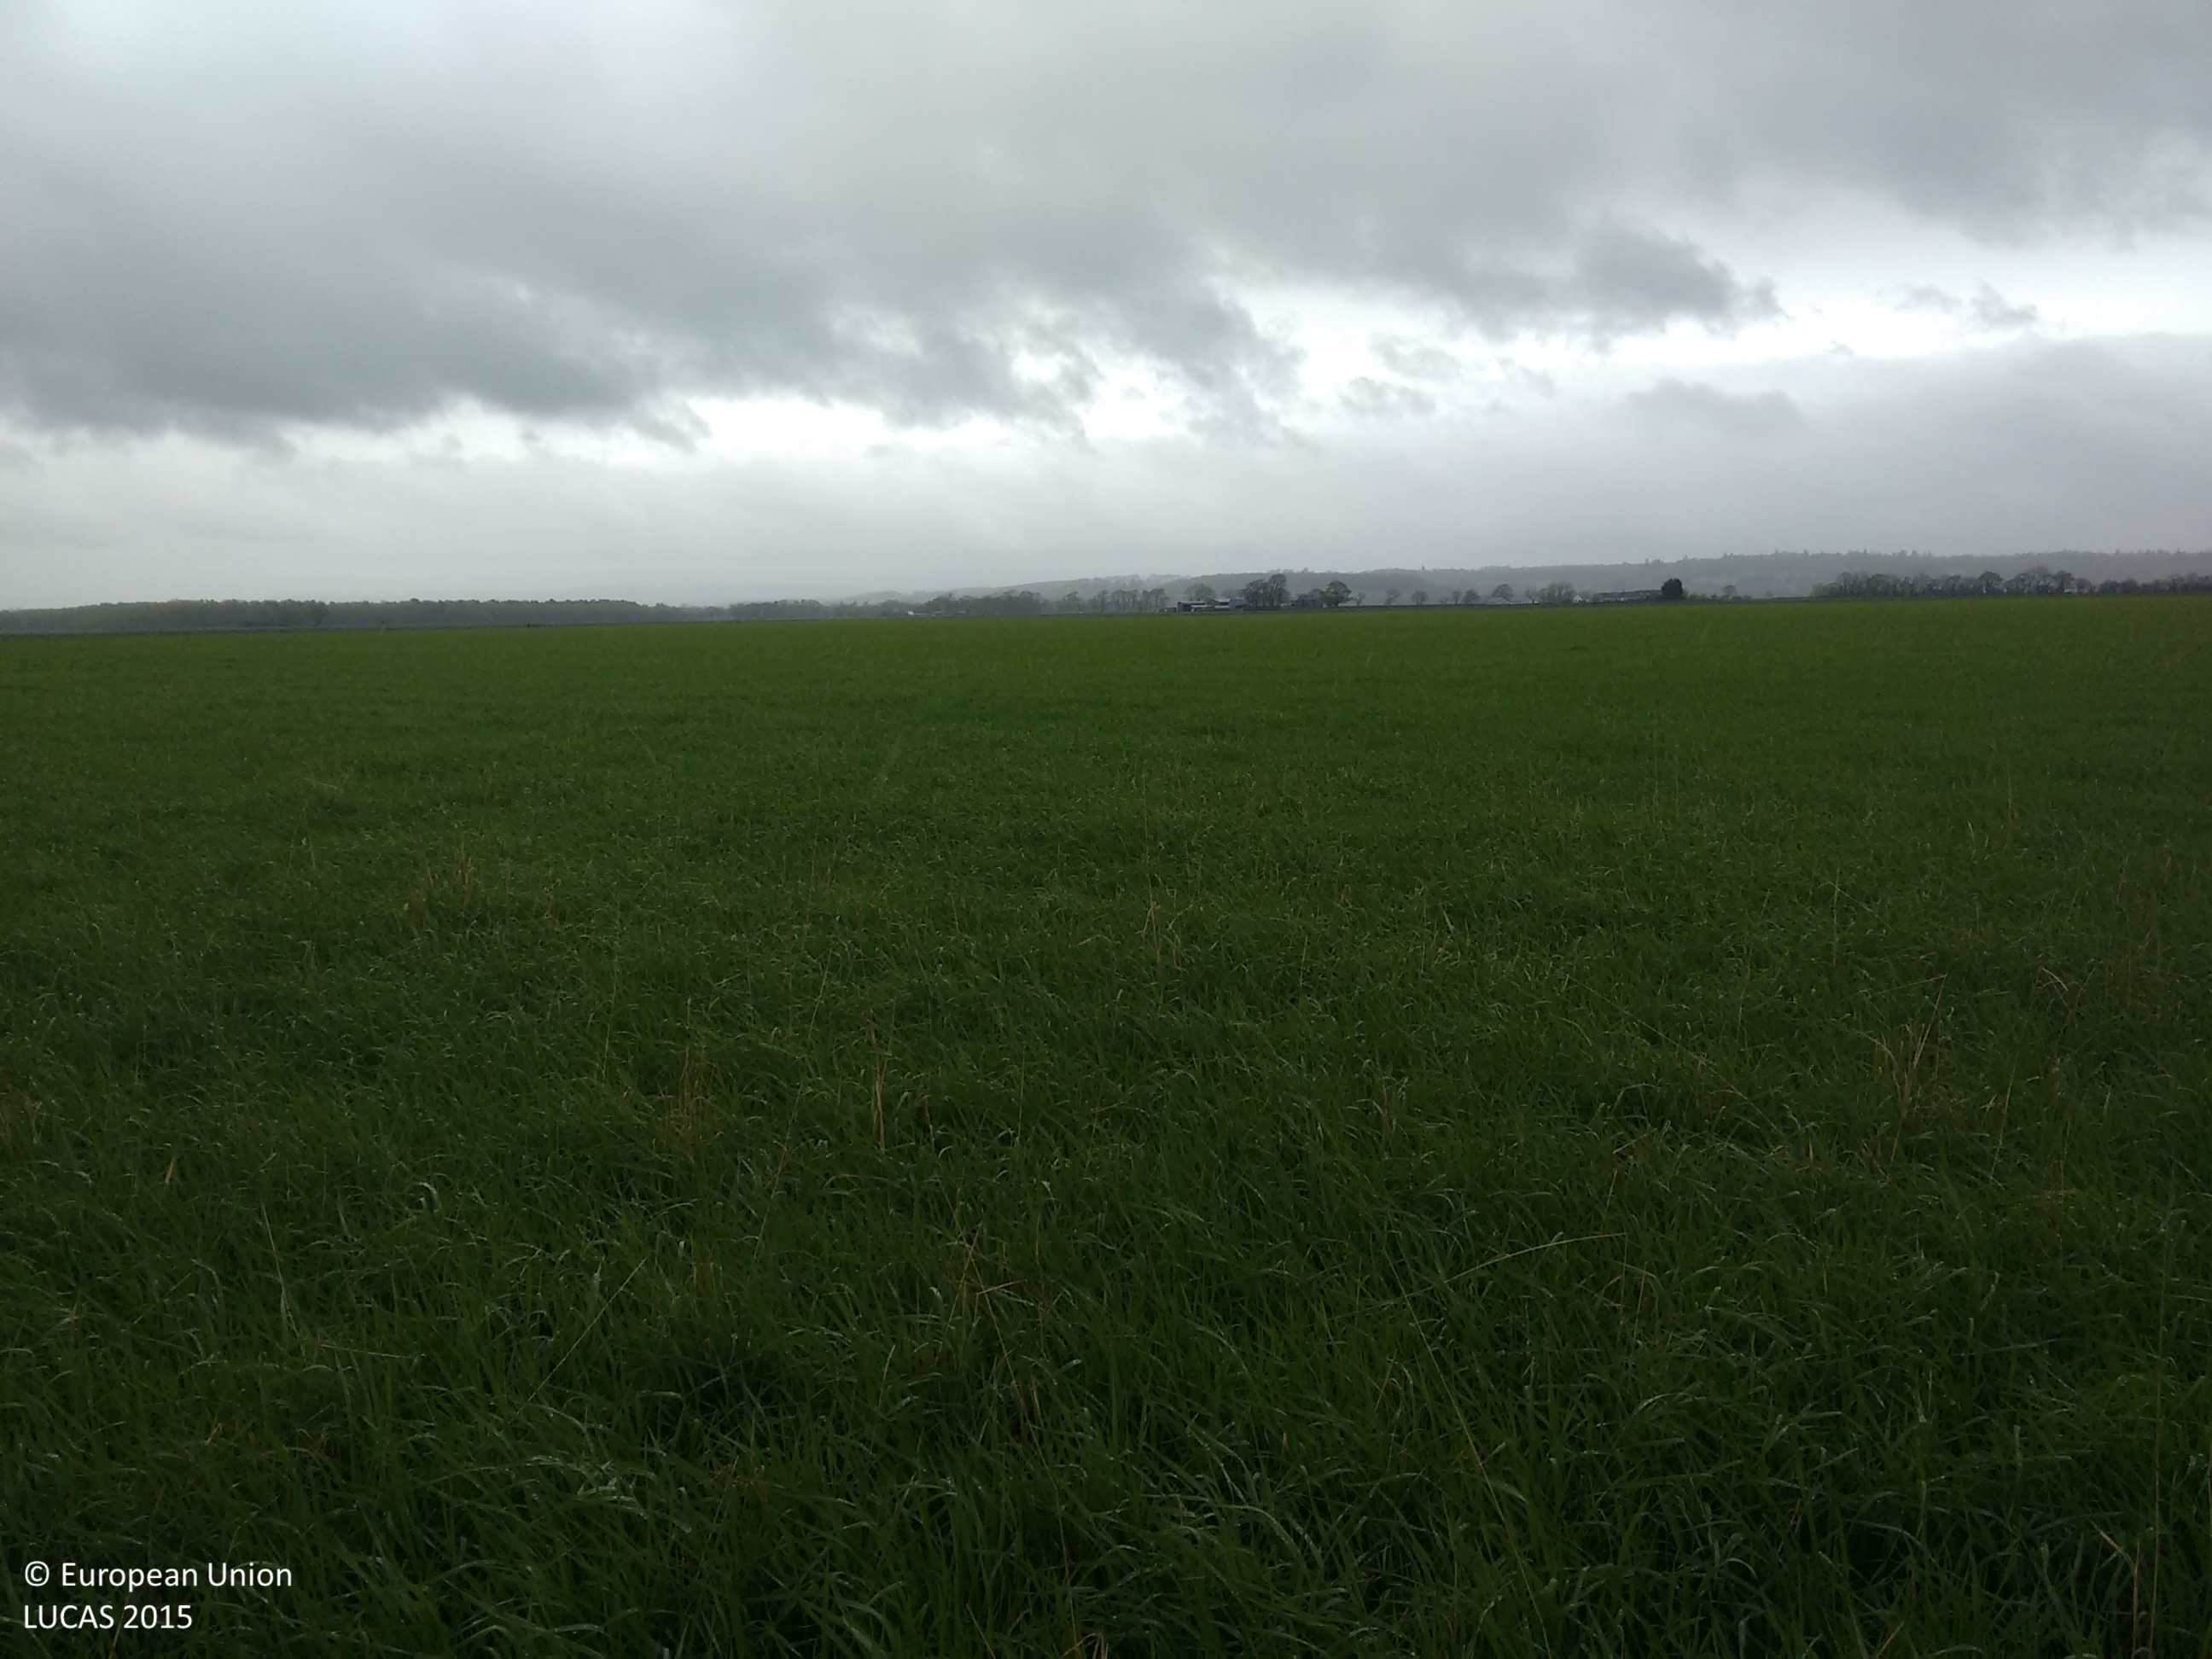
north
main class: Cropland
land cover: Mixed cereals for fodder
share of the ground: > 75 %
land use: Agriculture (excluding fallow land and kitchen gardens)
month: May
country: GB
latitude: 56.1277
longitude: -4.0028
